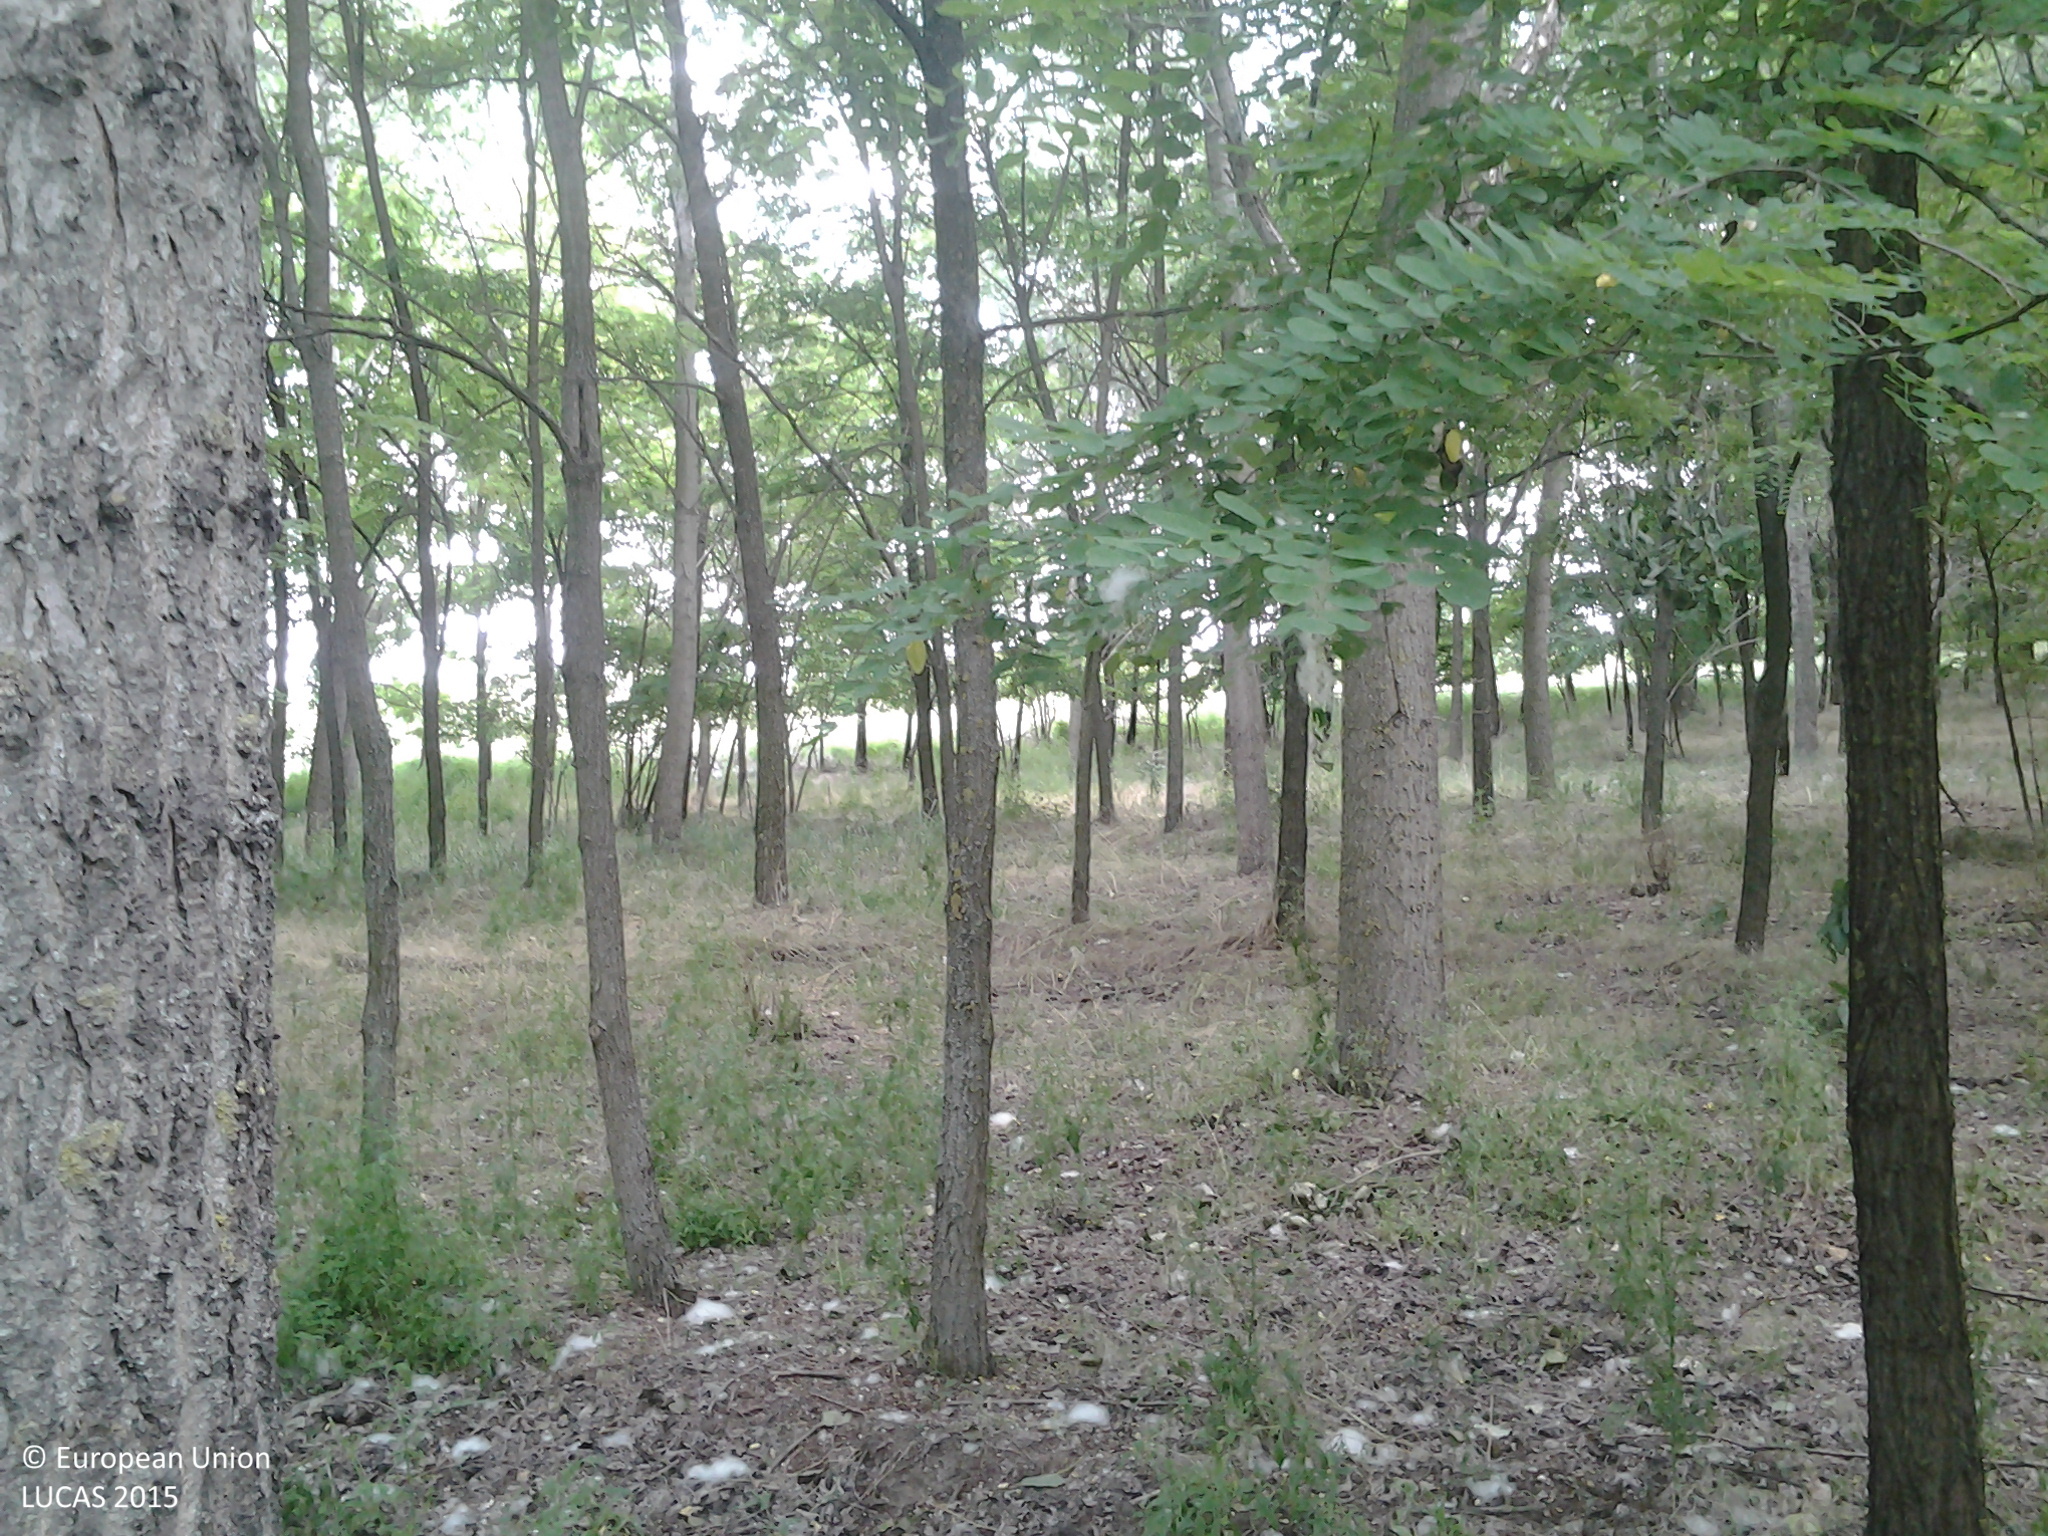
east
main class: Woodland
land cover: Broadleaved woodland
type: mesophytic deciduous forest
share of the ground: 25 - 50 %
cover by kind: broadleaved forest trees 100 %
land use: Forestry
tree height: > 5 m
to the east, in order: Broadleaved woodland; Grassland without tree/shrub cover; Electric lines; Grass margins; Tracks; Grassland without tree/shrub cover
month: June
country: HU
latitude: 46.7929
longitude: 19.7546
